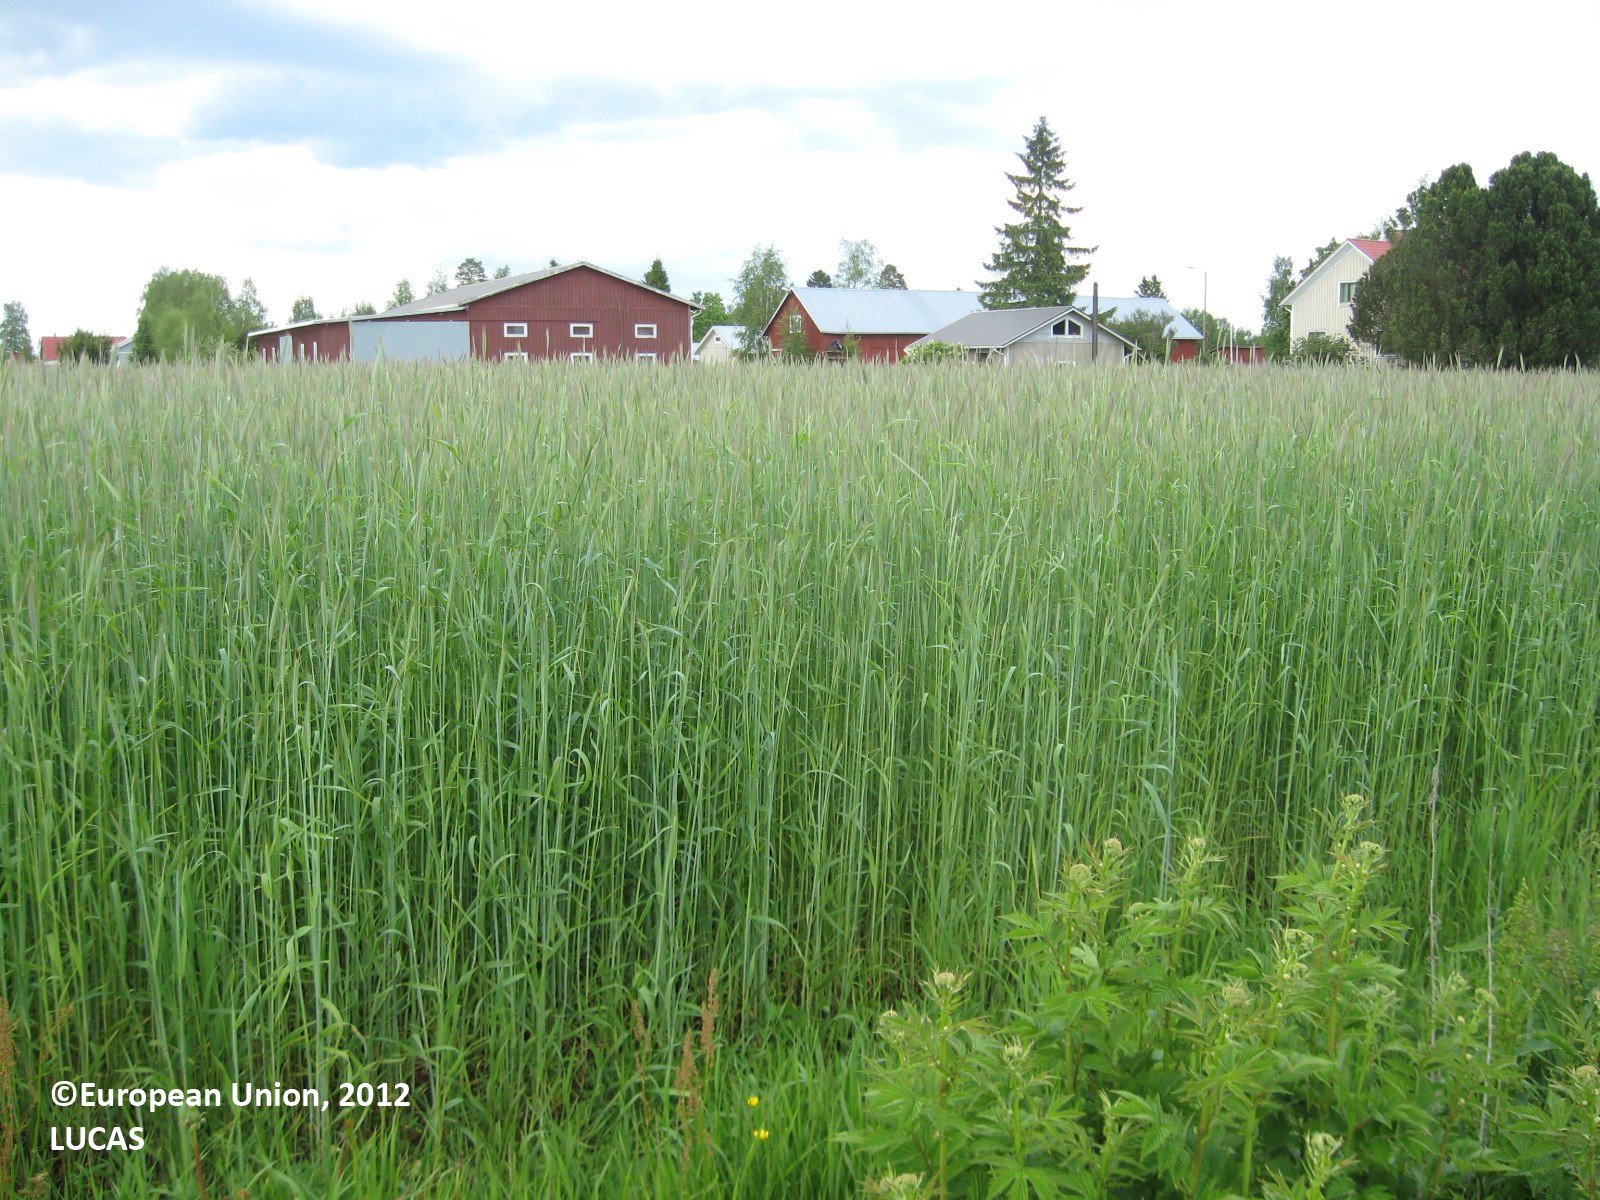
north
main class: Cropland
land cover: Barley
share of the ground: > 75 %
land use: Agriculture (excluding fallow land and kitchen gardens)
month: June
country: FI
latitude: 63.0658
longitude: 22.8590
